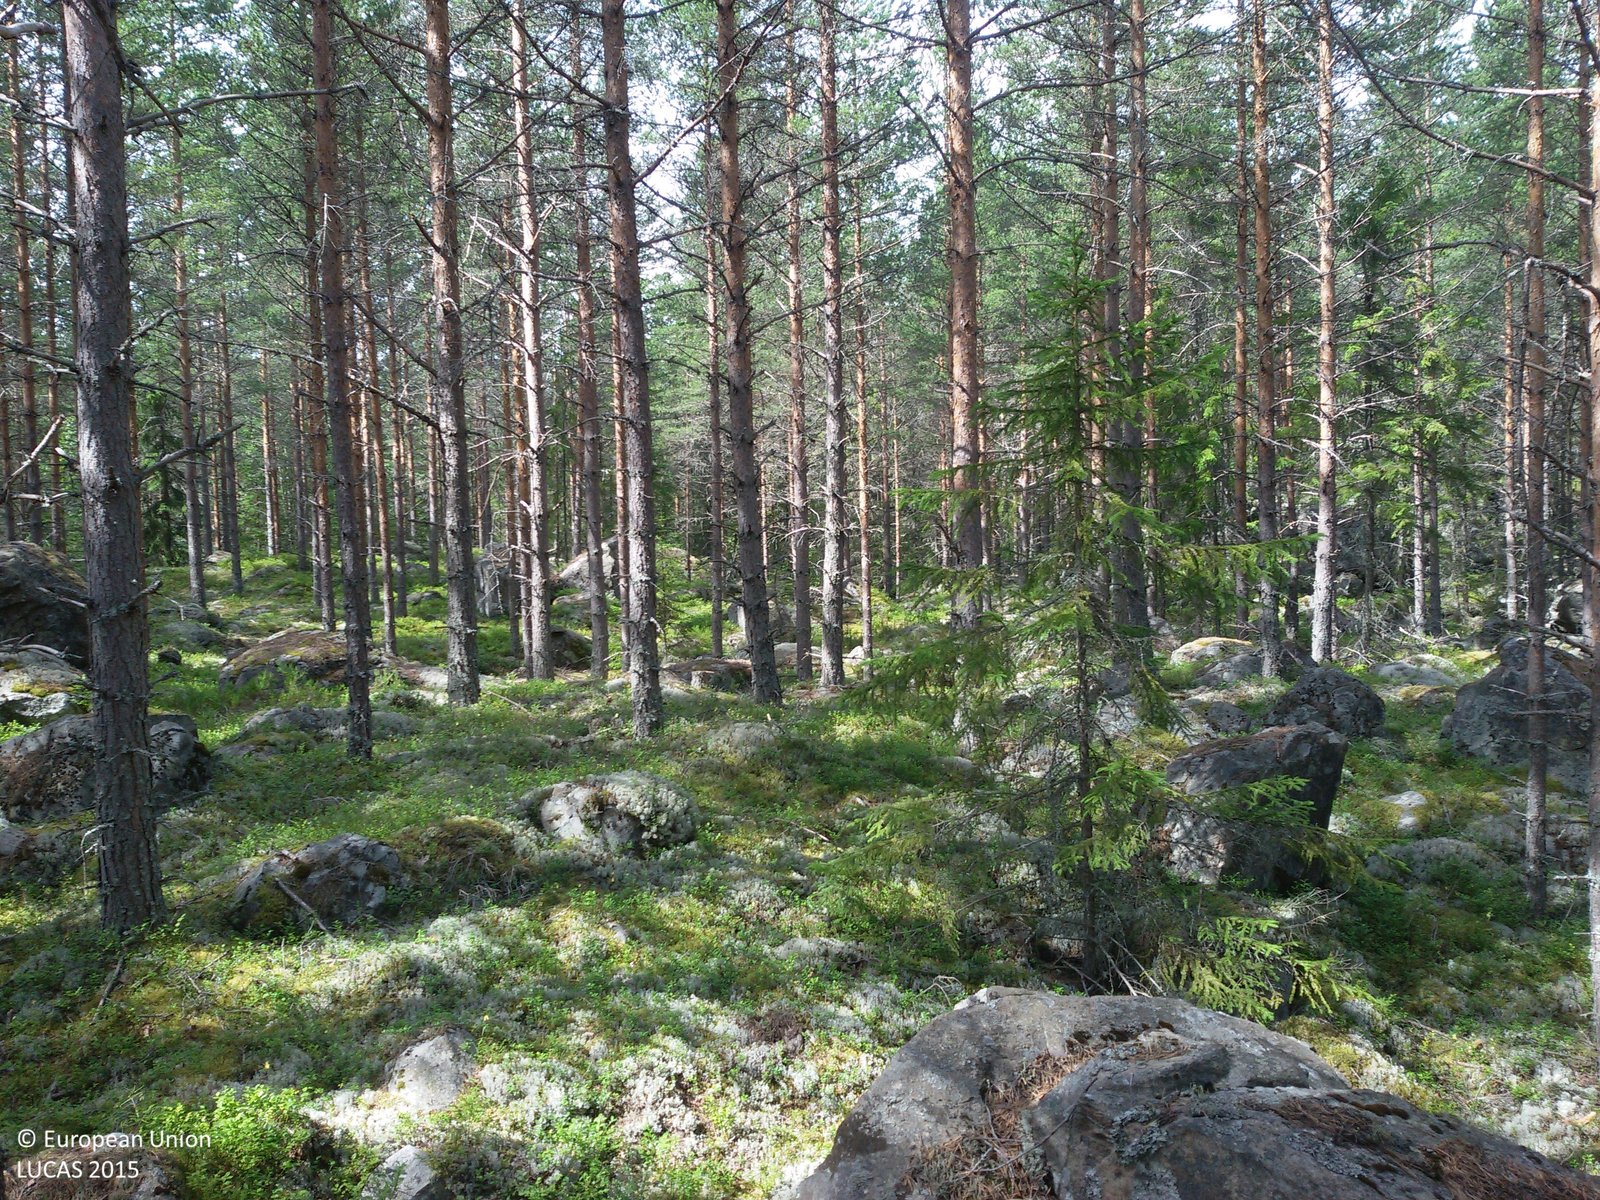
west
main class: Woodland
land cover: Pine dominated coniferous woodland
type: boreal forest
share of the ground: > 75 %
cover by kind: coniferous forest trees 80 %, shrubs 15 %, lichens and mosses 5 %
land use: Forestry
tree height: > 5 m
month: July
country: SE
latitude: 60.6362
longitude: 15.4170
